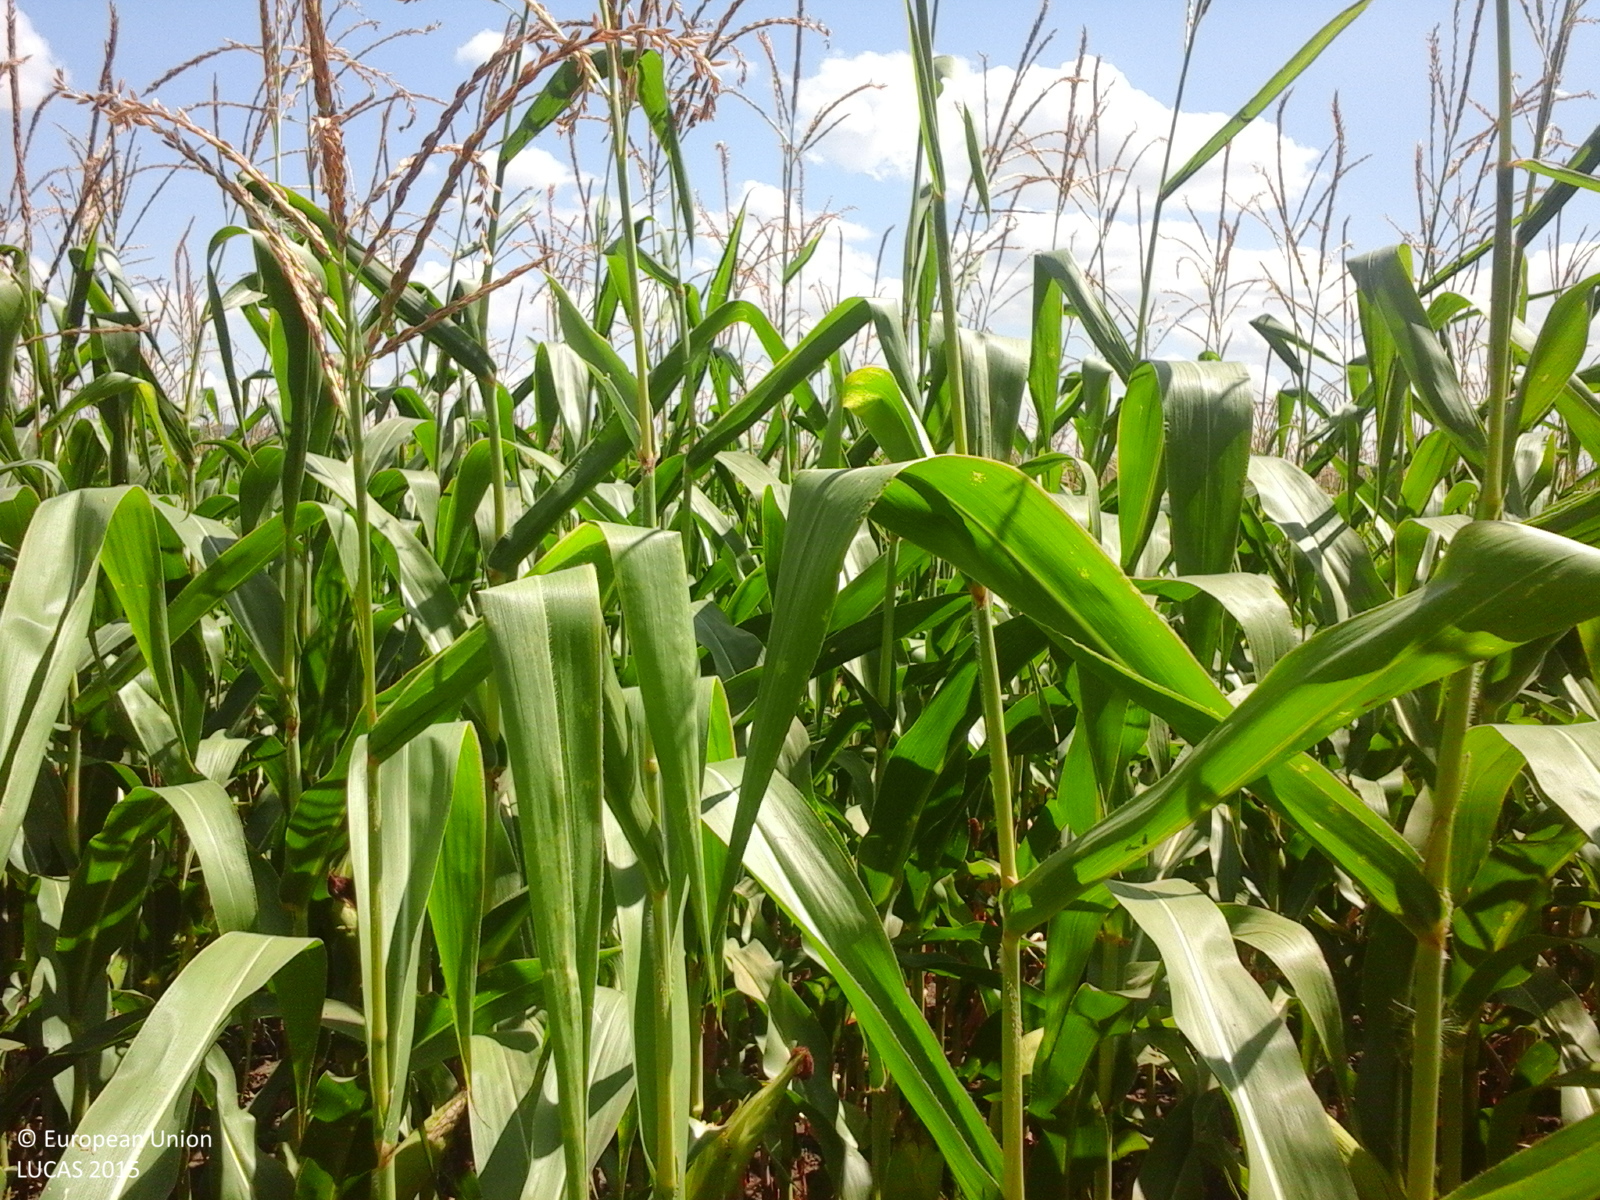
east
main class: Cropland
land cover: Maize
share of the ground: > 75 %
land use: Agriculture (excluding fallow land and kitchen gardens)
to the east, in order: Maize
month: July
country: RO
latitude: 46.5529
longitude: 27.8203
